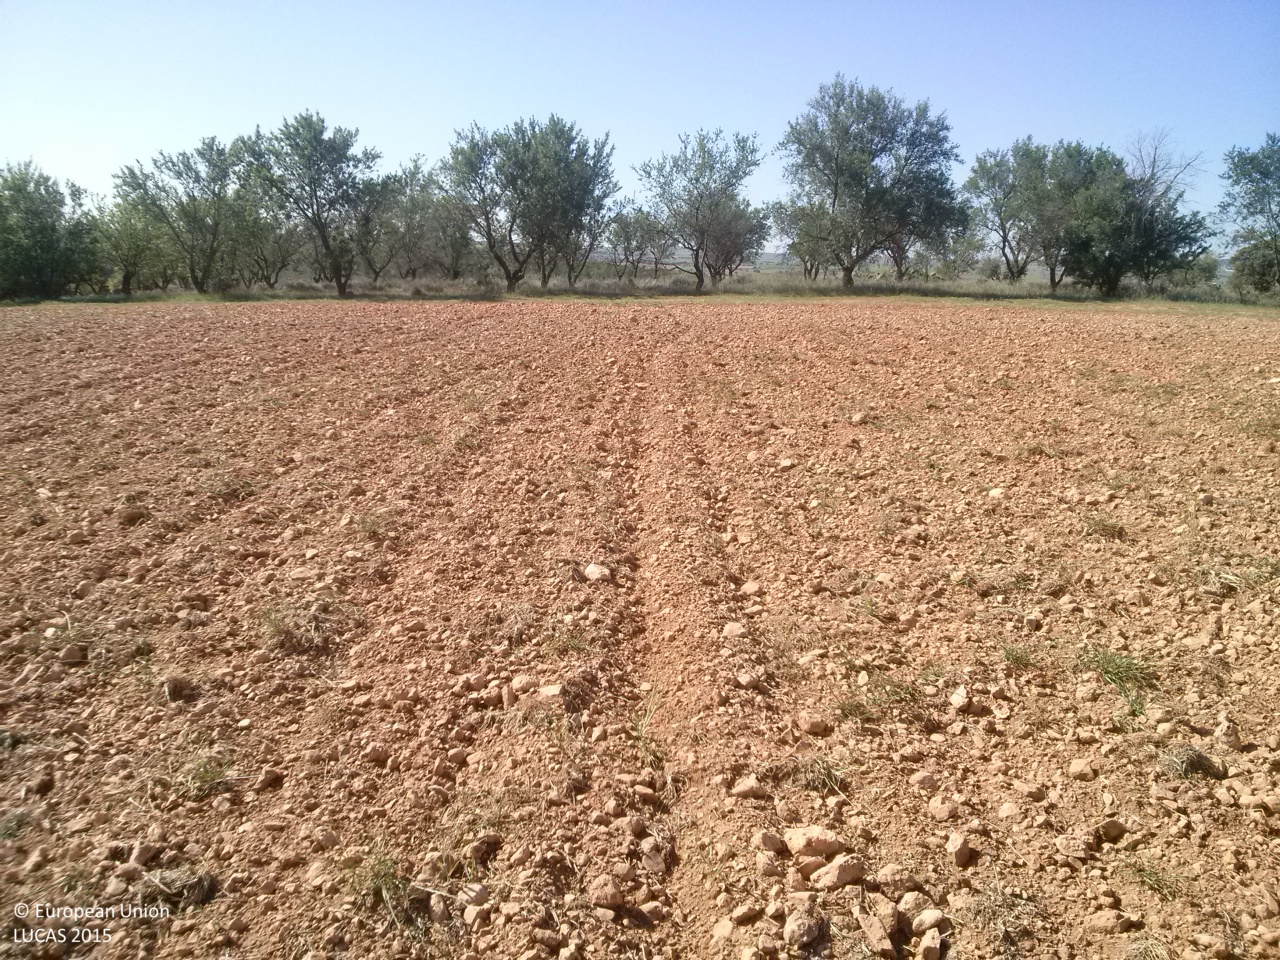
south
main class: Grassland
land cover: Spontaneously vegetated surfaces
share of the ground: 10 - 25 %
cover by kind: unconsolidated bare surface 85 %, herbaceous plants 15 %
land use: Fallow land
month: May
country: ES
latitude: 39.8468
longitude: -2.7935
